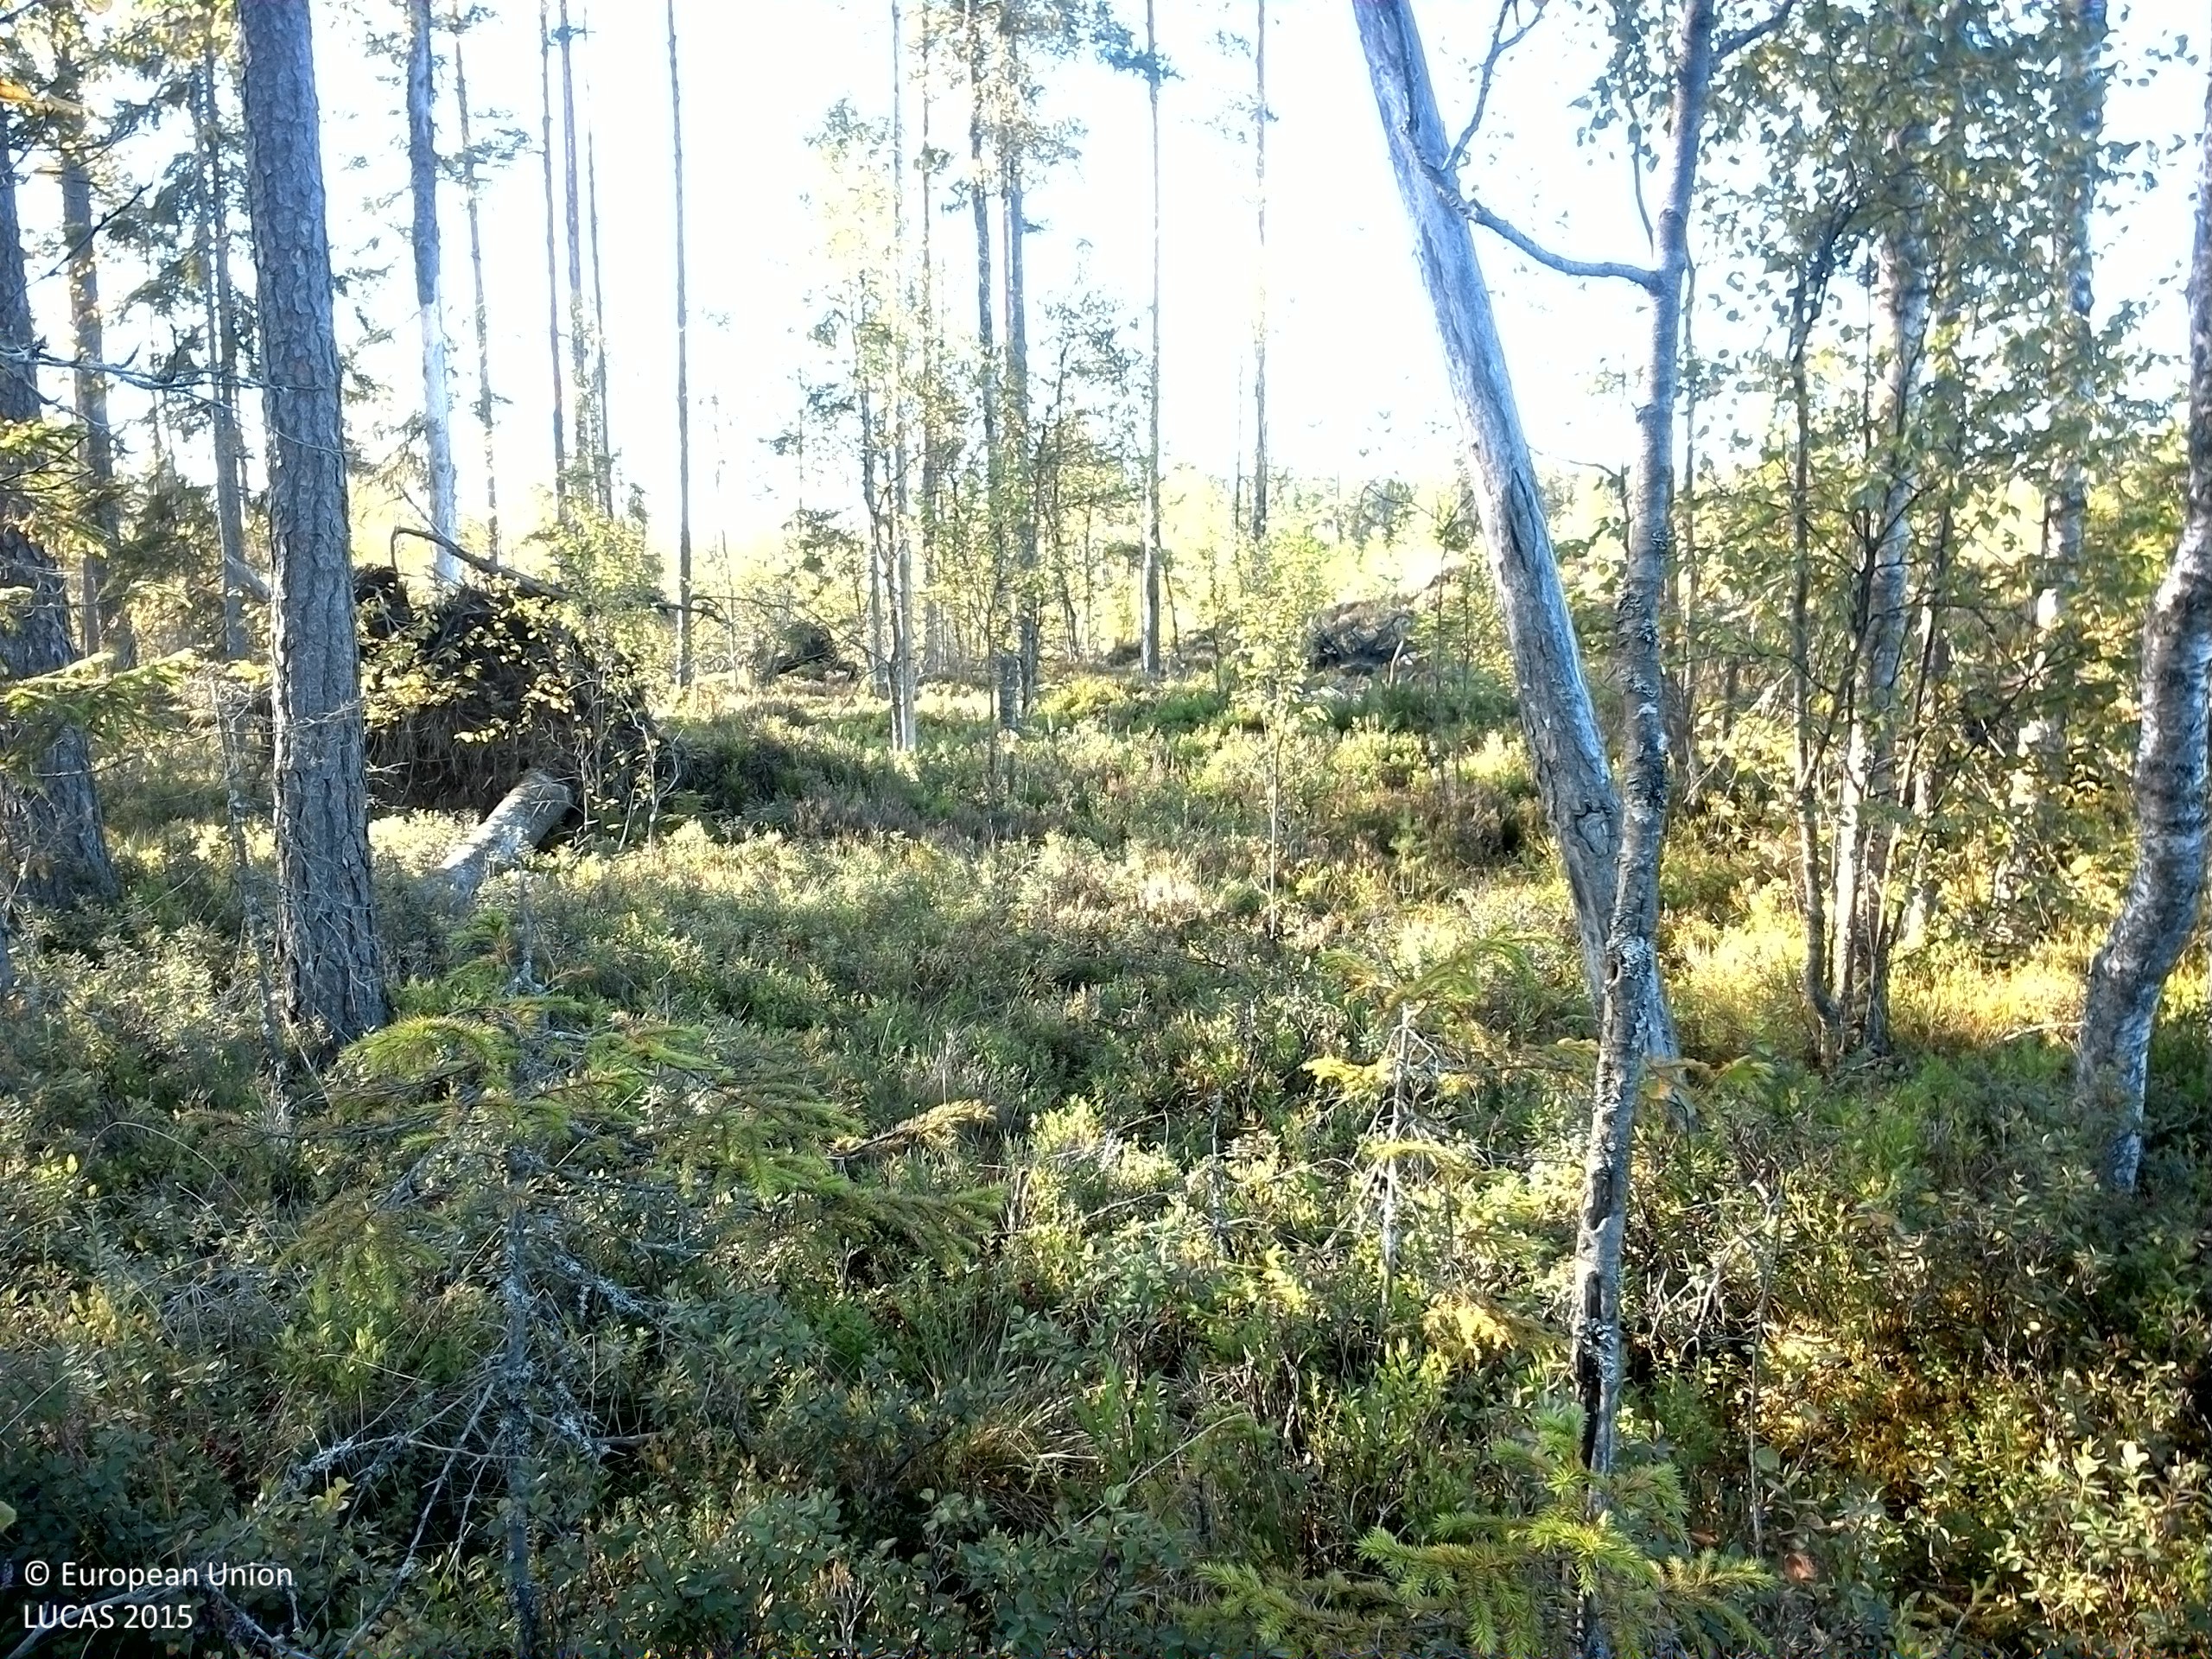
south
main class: Woodland
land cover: Pine dominated coniferous woodland
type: boreal forest
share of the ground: 50 - 75 %
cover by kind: coniferous forest trees 65 %, shrubs 25 %, broadleaved forest trees 5 %, lichens and mosses 5 %
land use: Forestry
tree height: > 5 m
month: September
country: SE
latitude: 59.8334
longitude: 13.3989
